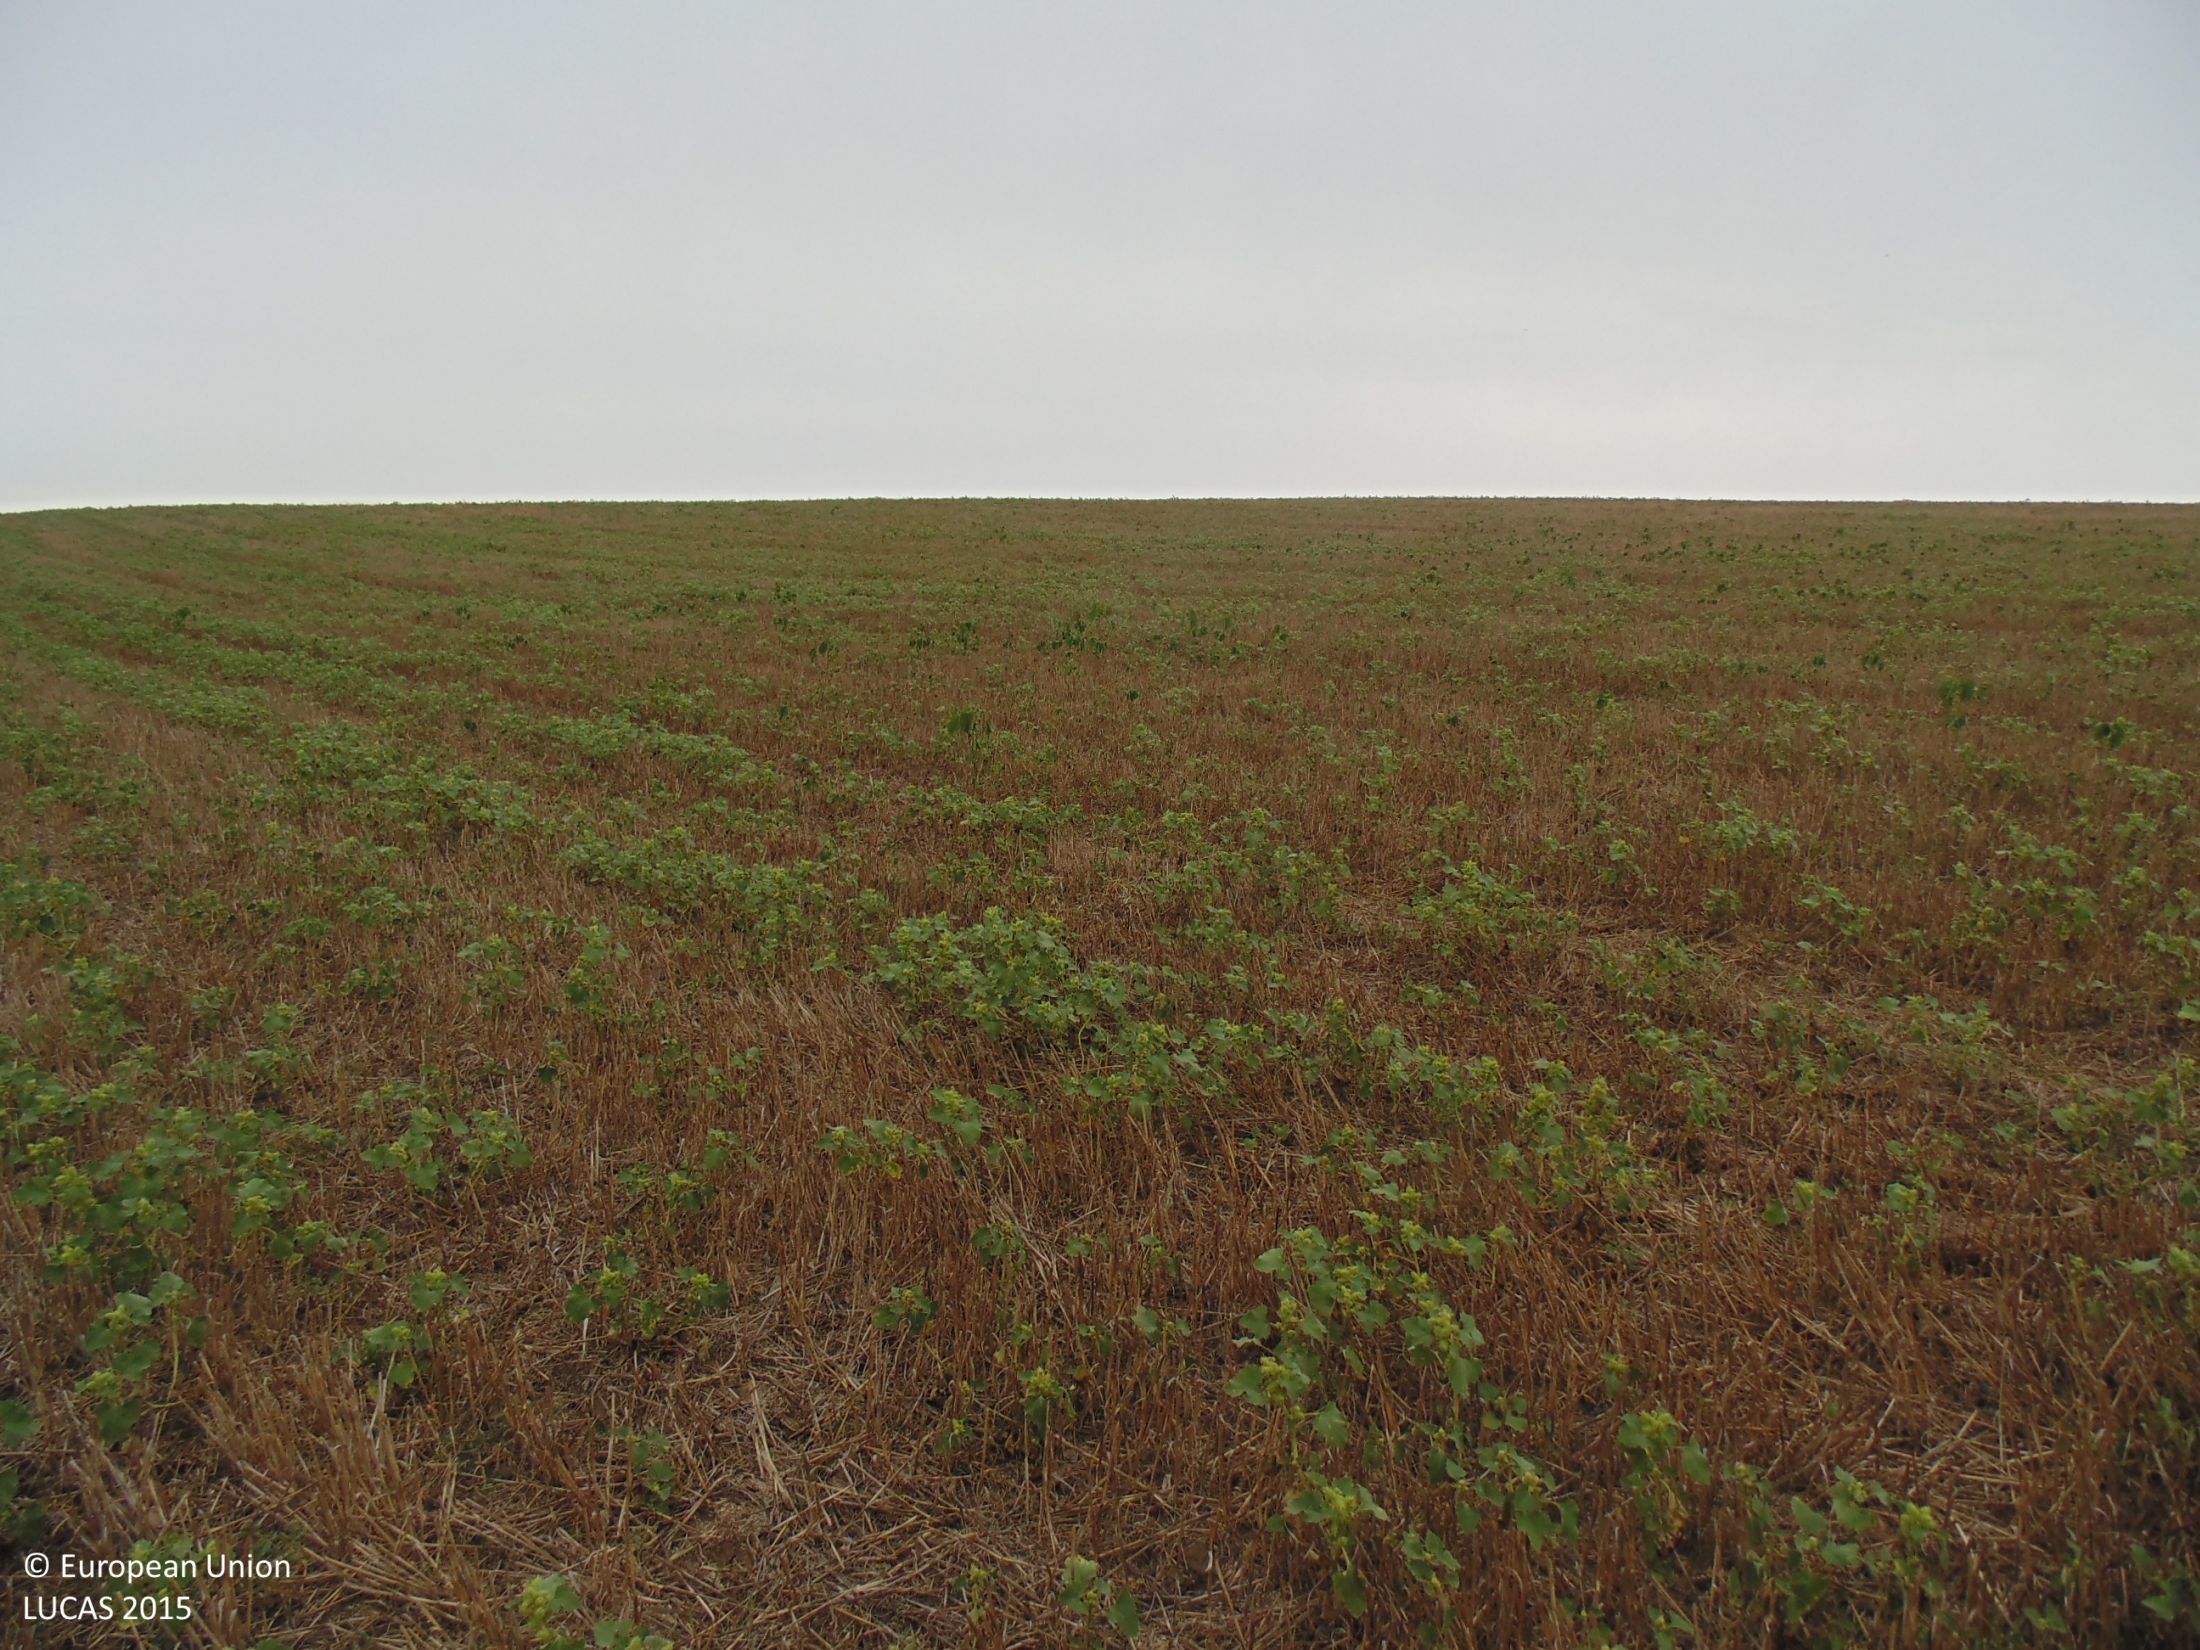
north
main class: Cropland
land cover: Common wheat
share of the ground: 10 - 25 %
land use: Agriculture (excluding fallow land and kitchen gardens)
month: September
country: BG
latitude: 44.0351
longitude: 27.1352
